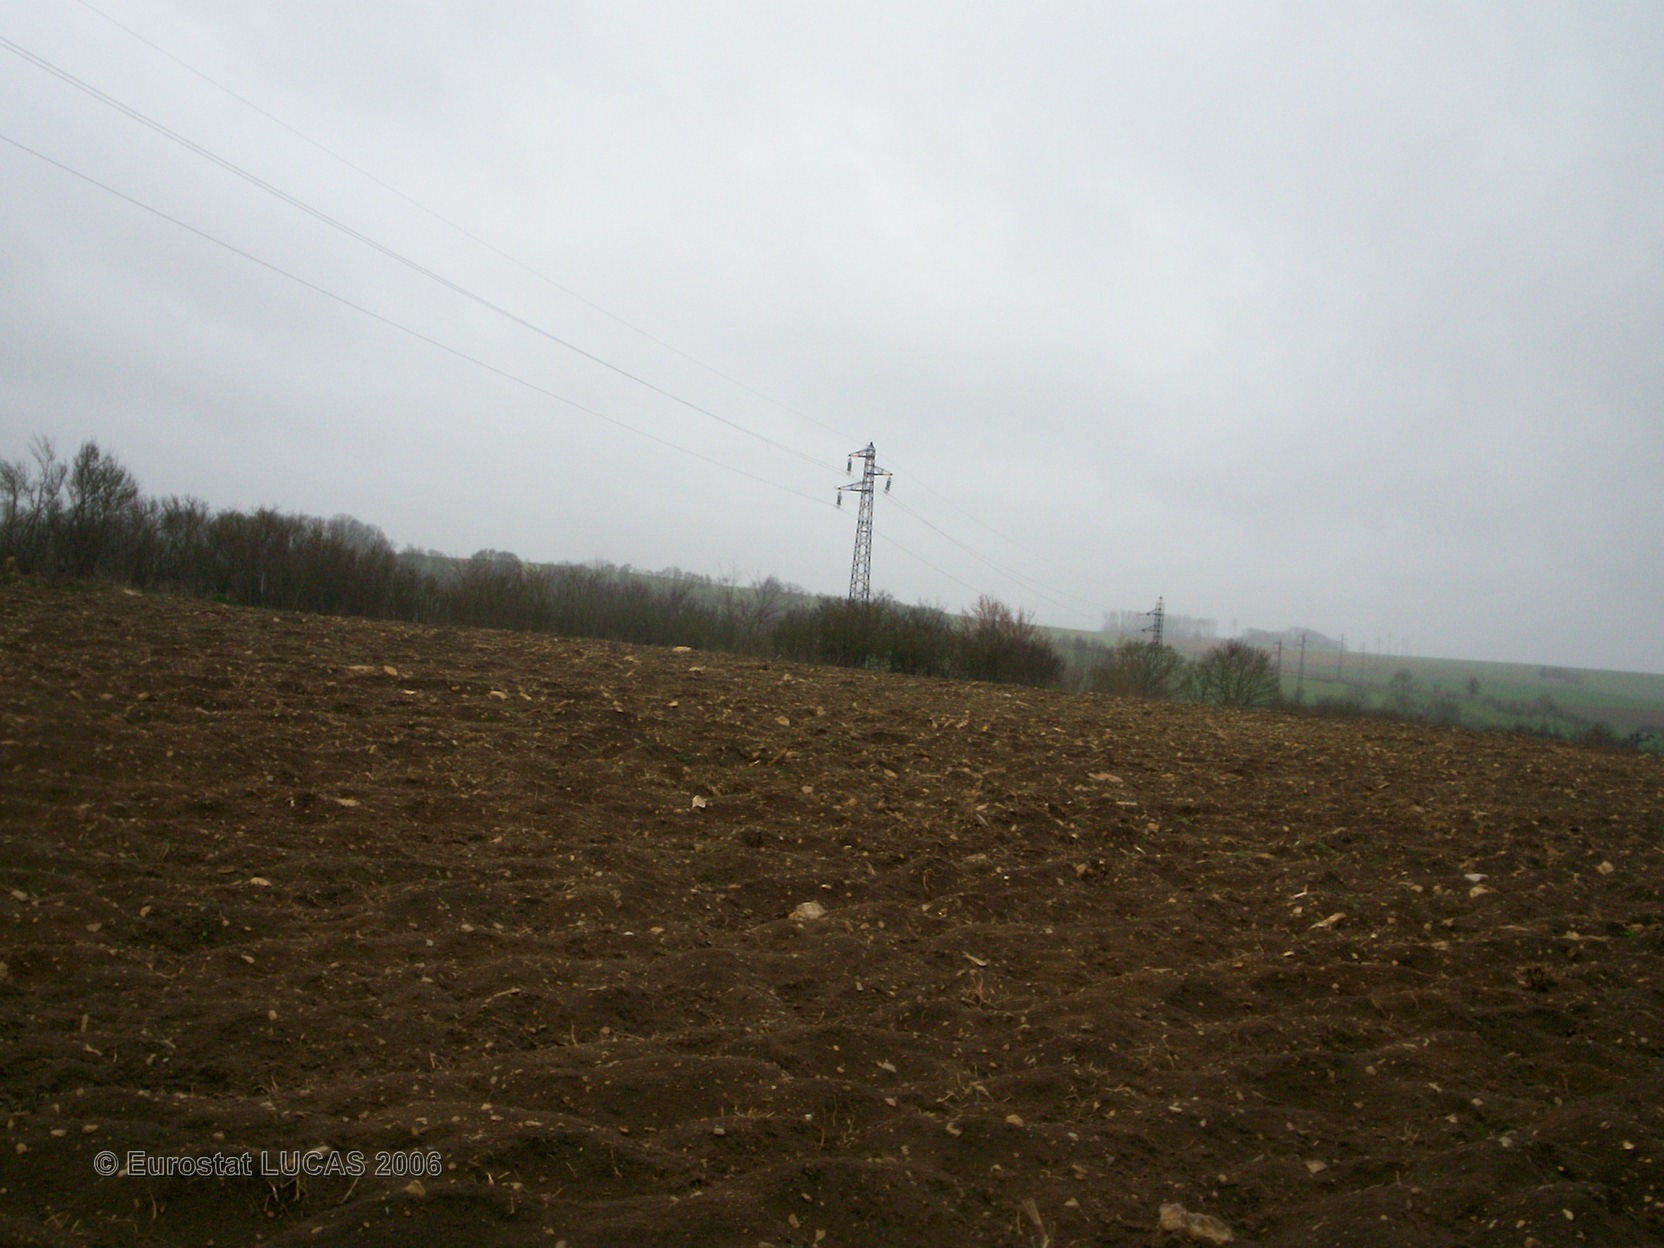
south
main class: Cropland
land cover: Maize
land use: Agriculture (excluding fallow land and kitchen gardens)
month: May
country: FR
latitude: 48.6854
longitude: 6.9443
